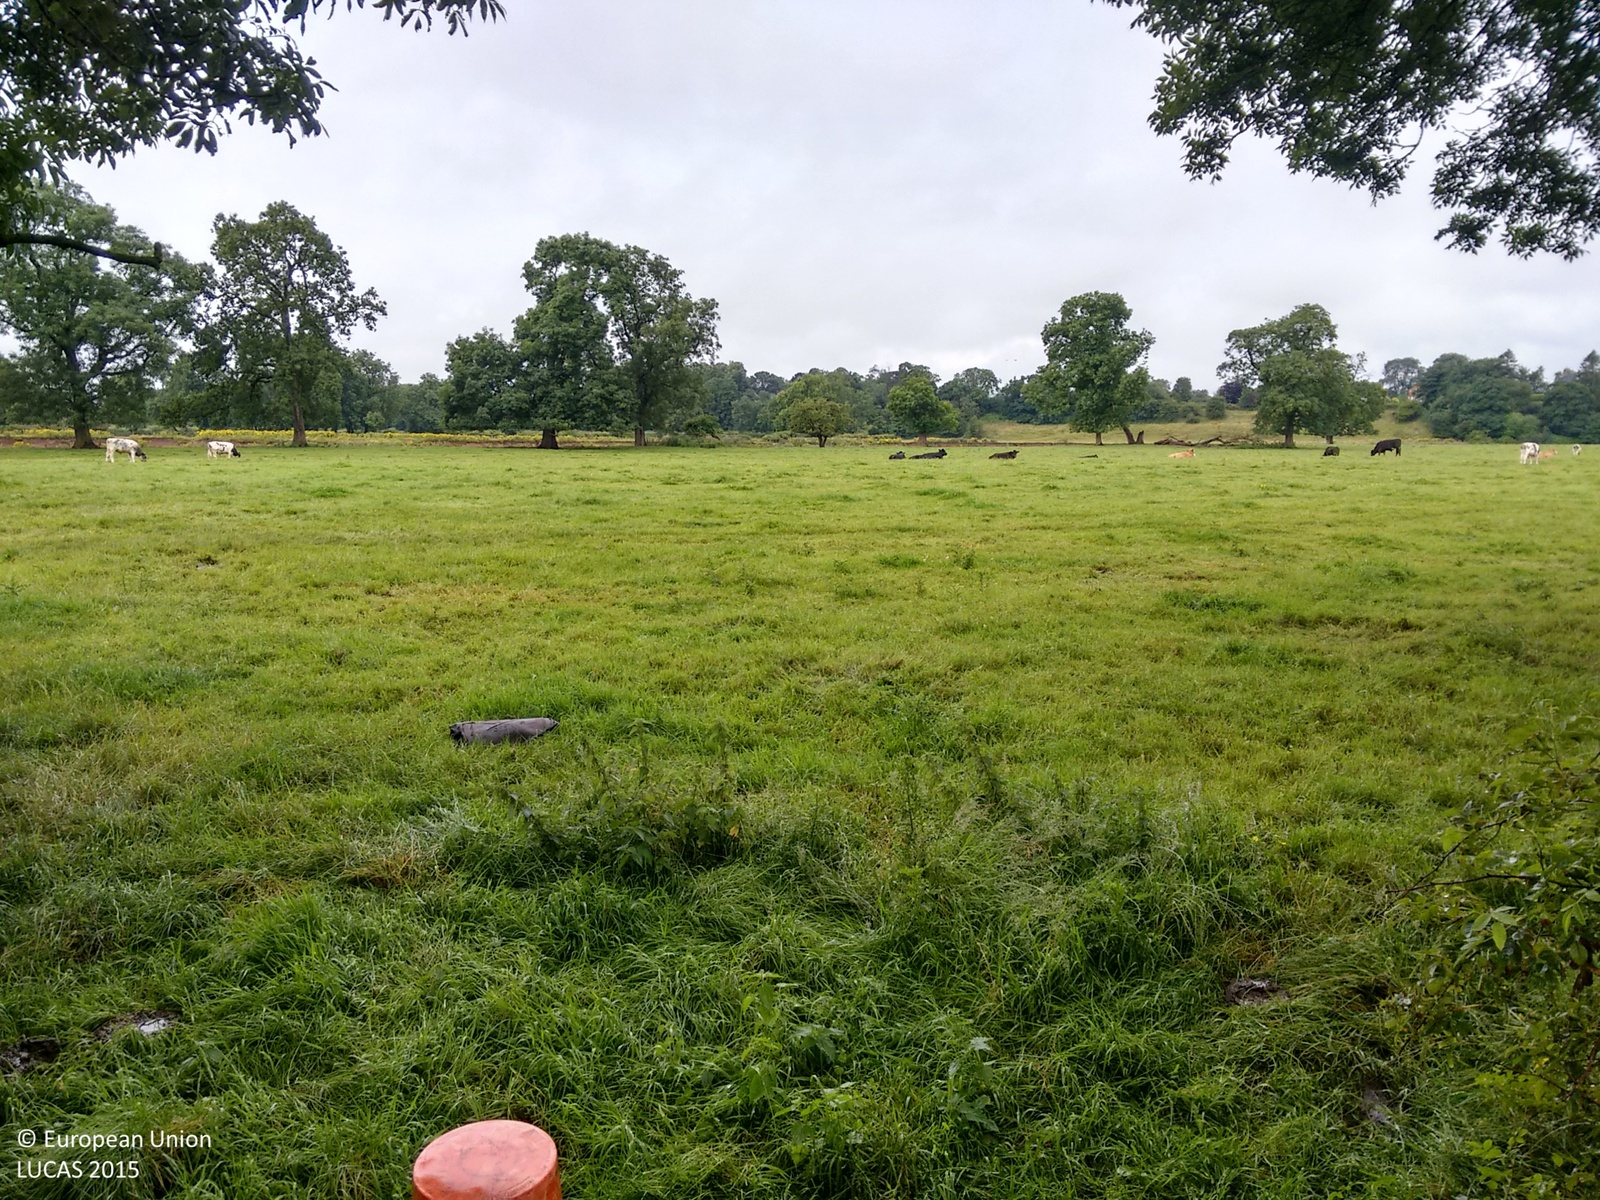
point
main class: Grassland
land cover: Grassland without tree/shrub cover
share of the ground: > 75 %
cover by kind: herbaceous plants 100 %
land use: Agriculture (excluding fallow land and kitchen gardens)
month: July
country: GB
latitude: 54.9204
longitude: -3.0057
